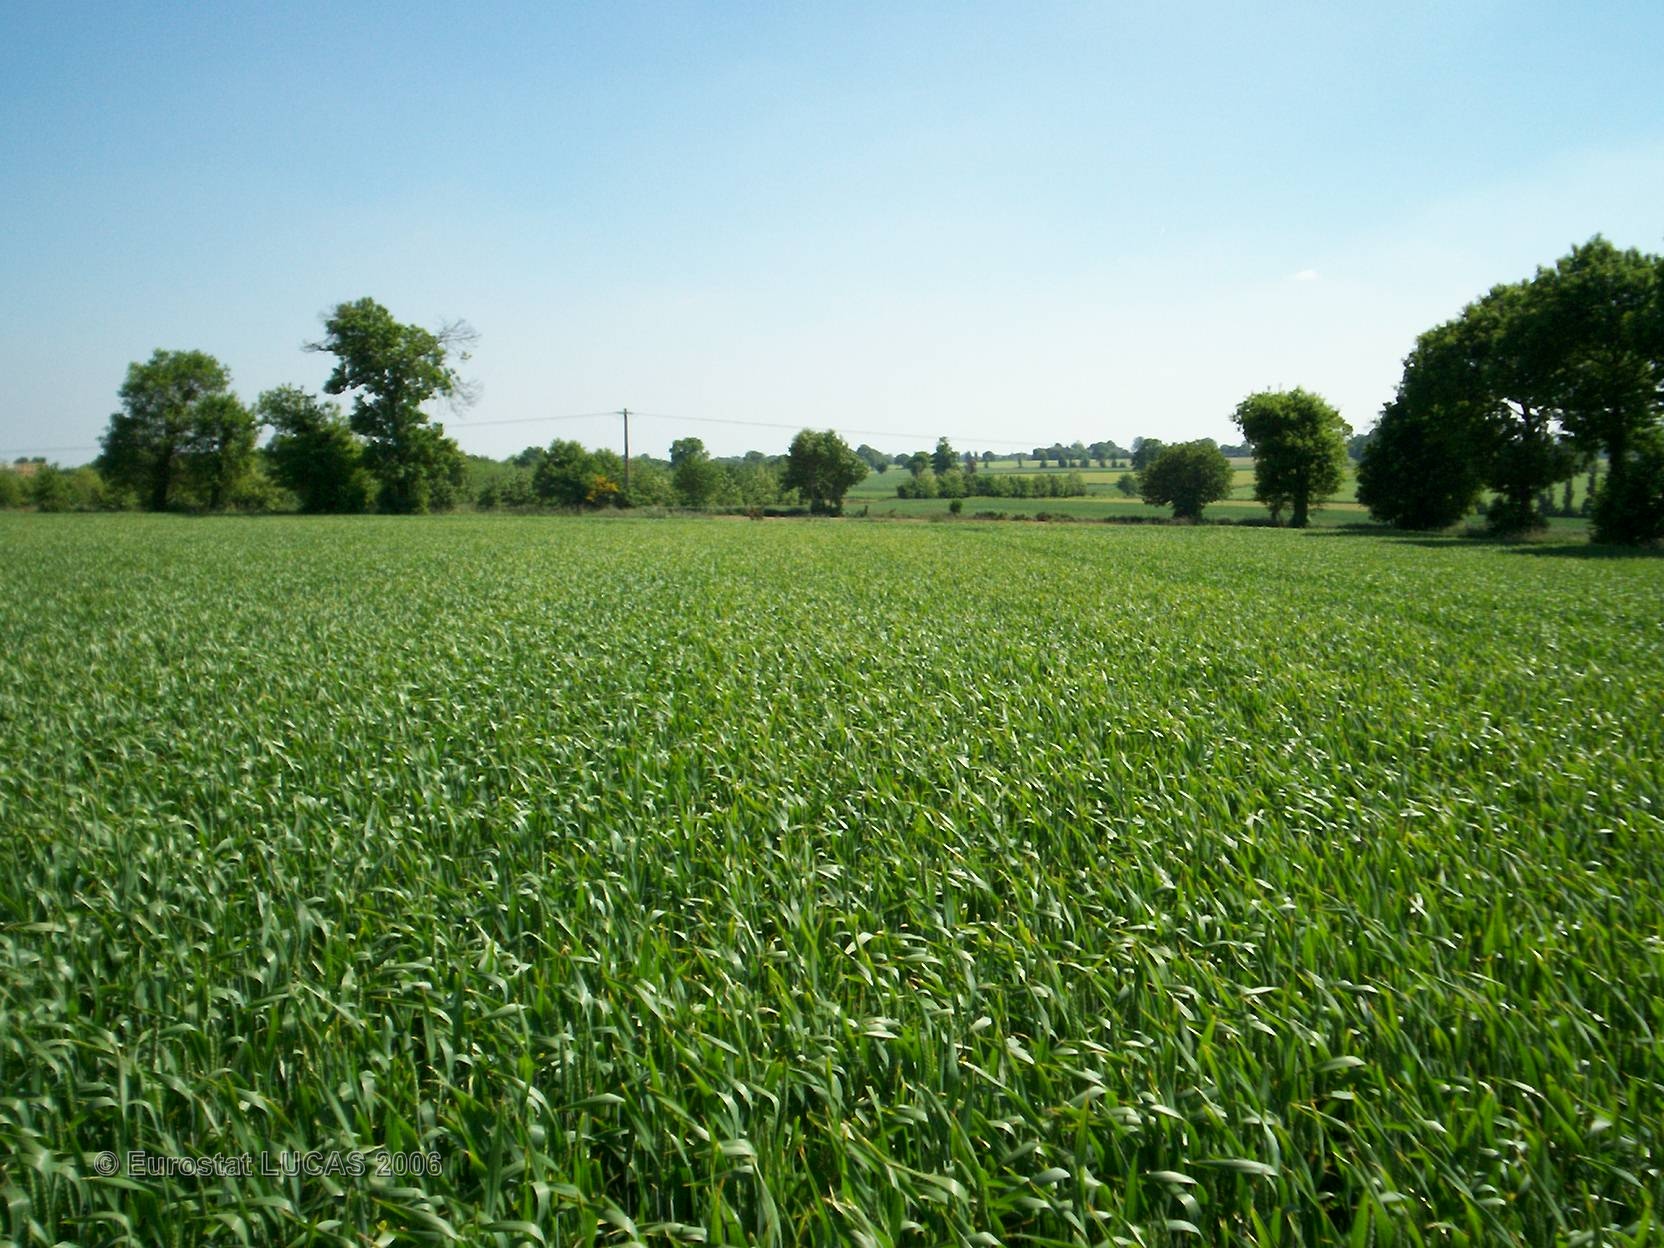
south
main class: Cropland
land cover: Common wheat
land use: Agriculture (excluding fallow land and kitchen gardens)
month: June
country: FR
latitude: 48.4180
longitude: -1.6830
